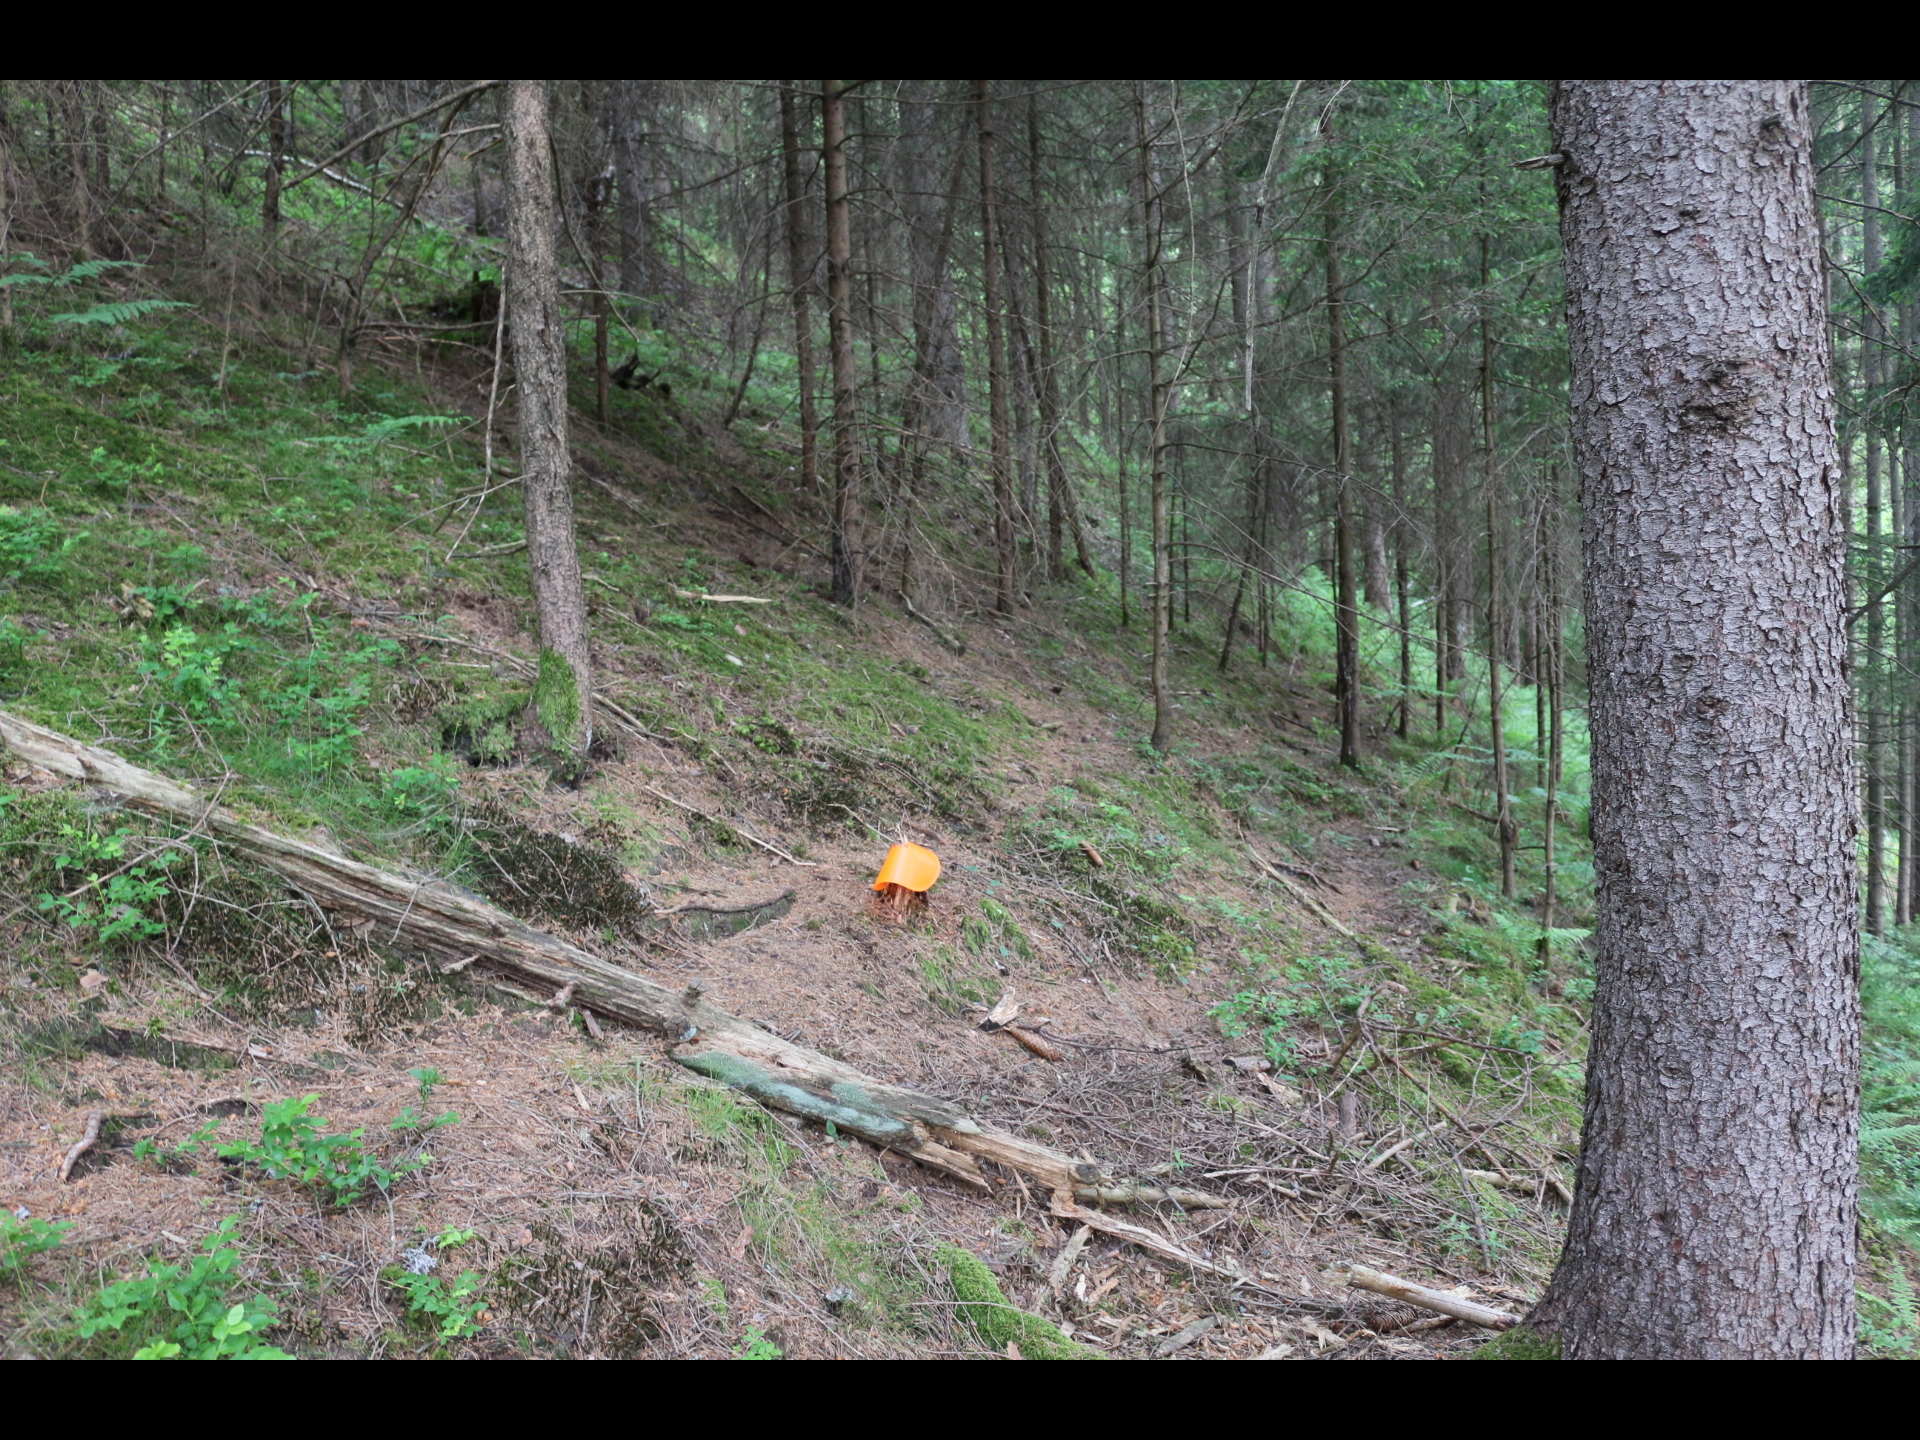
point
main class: Woodland
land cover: Spruce dominated coniferous woodland
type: alpine coniferous forest
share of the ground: > 75 %
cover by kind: coniferous forest trees 100 %
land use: Forestry
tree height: > 5 m
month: May
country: AT
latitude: 46.7007
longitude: 14.2219
